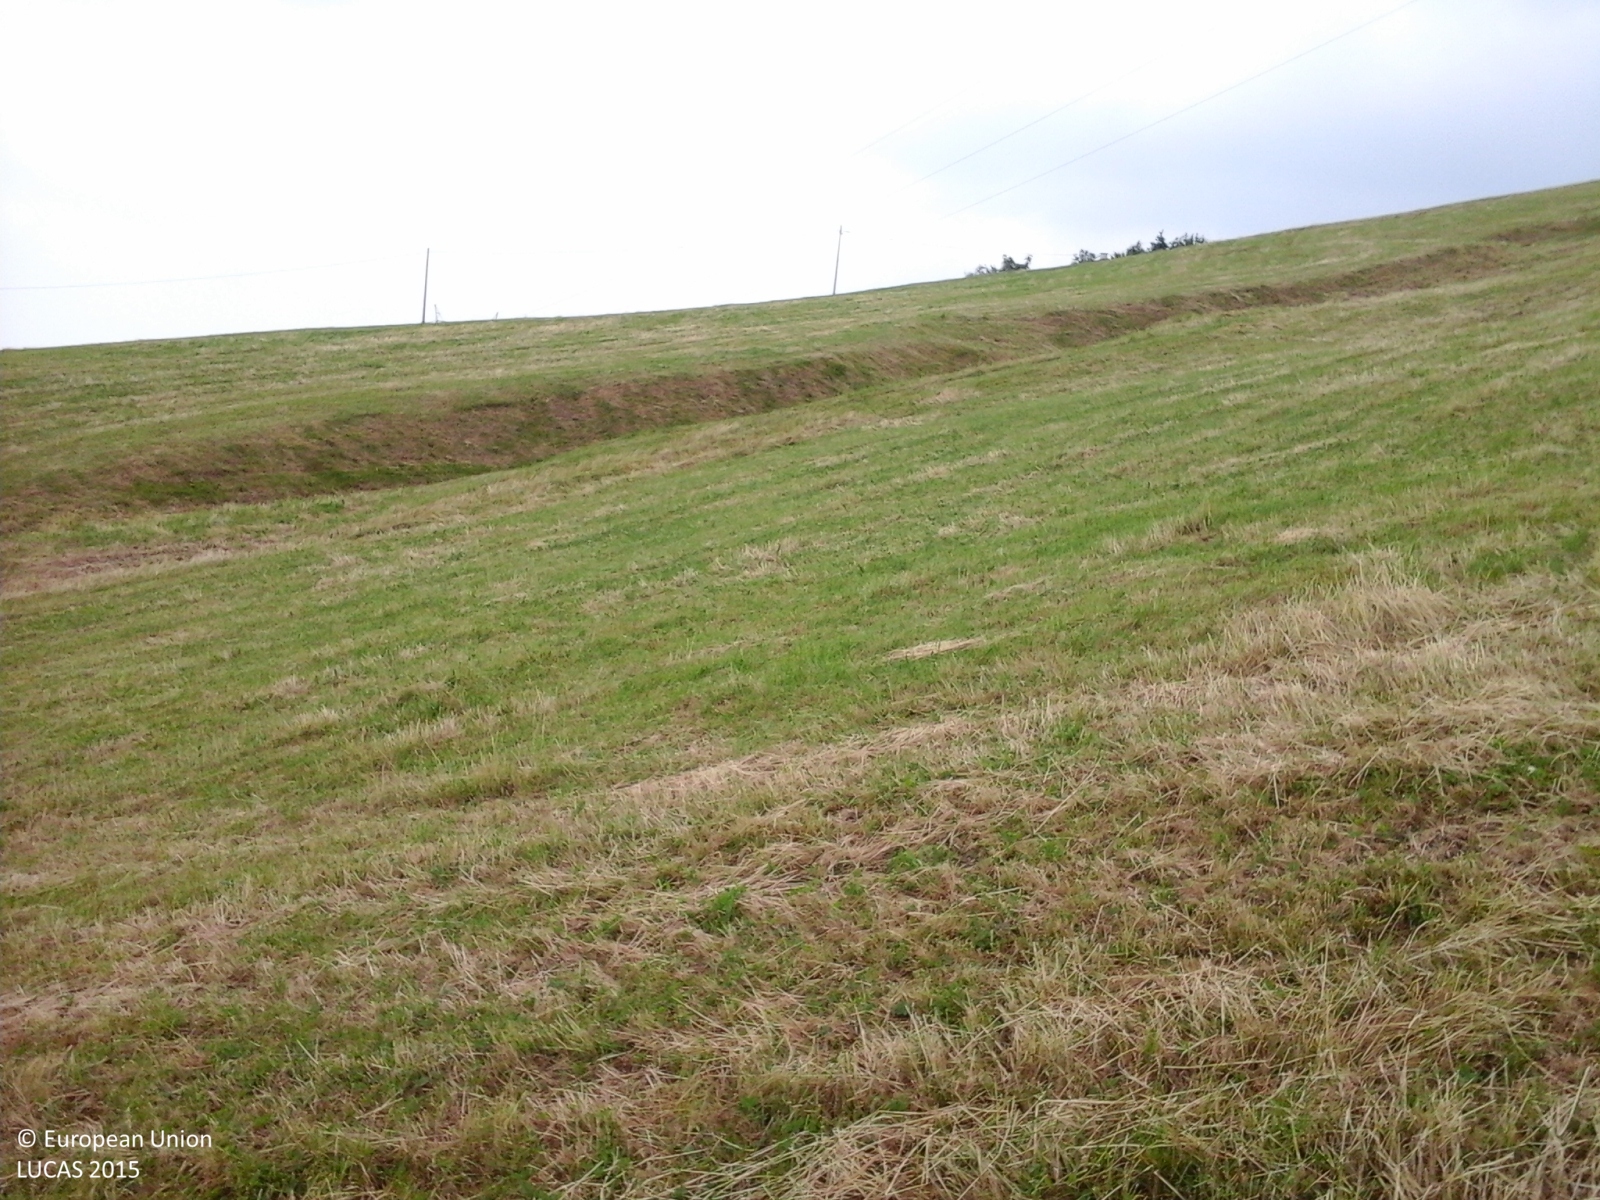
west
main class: Grassland
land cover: Grassland without tree/shrub cover
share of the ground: > 75 %
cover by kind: herbaceous plants 100 %
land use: Agriculture (excluding fallow land and kitchen gardens)
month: June
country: IT
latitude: 45.8166
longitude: 11.6064
